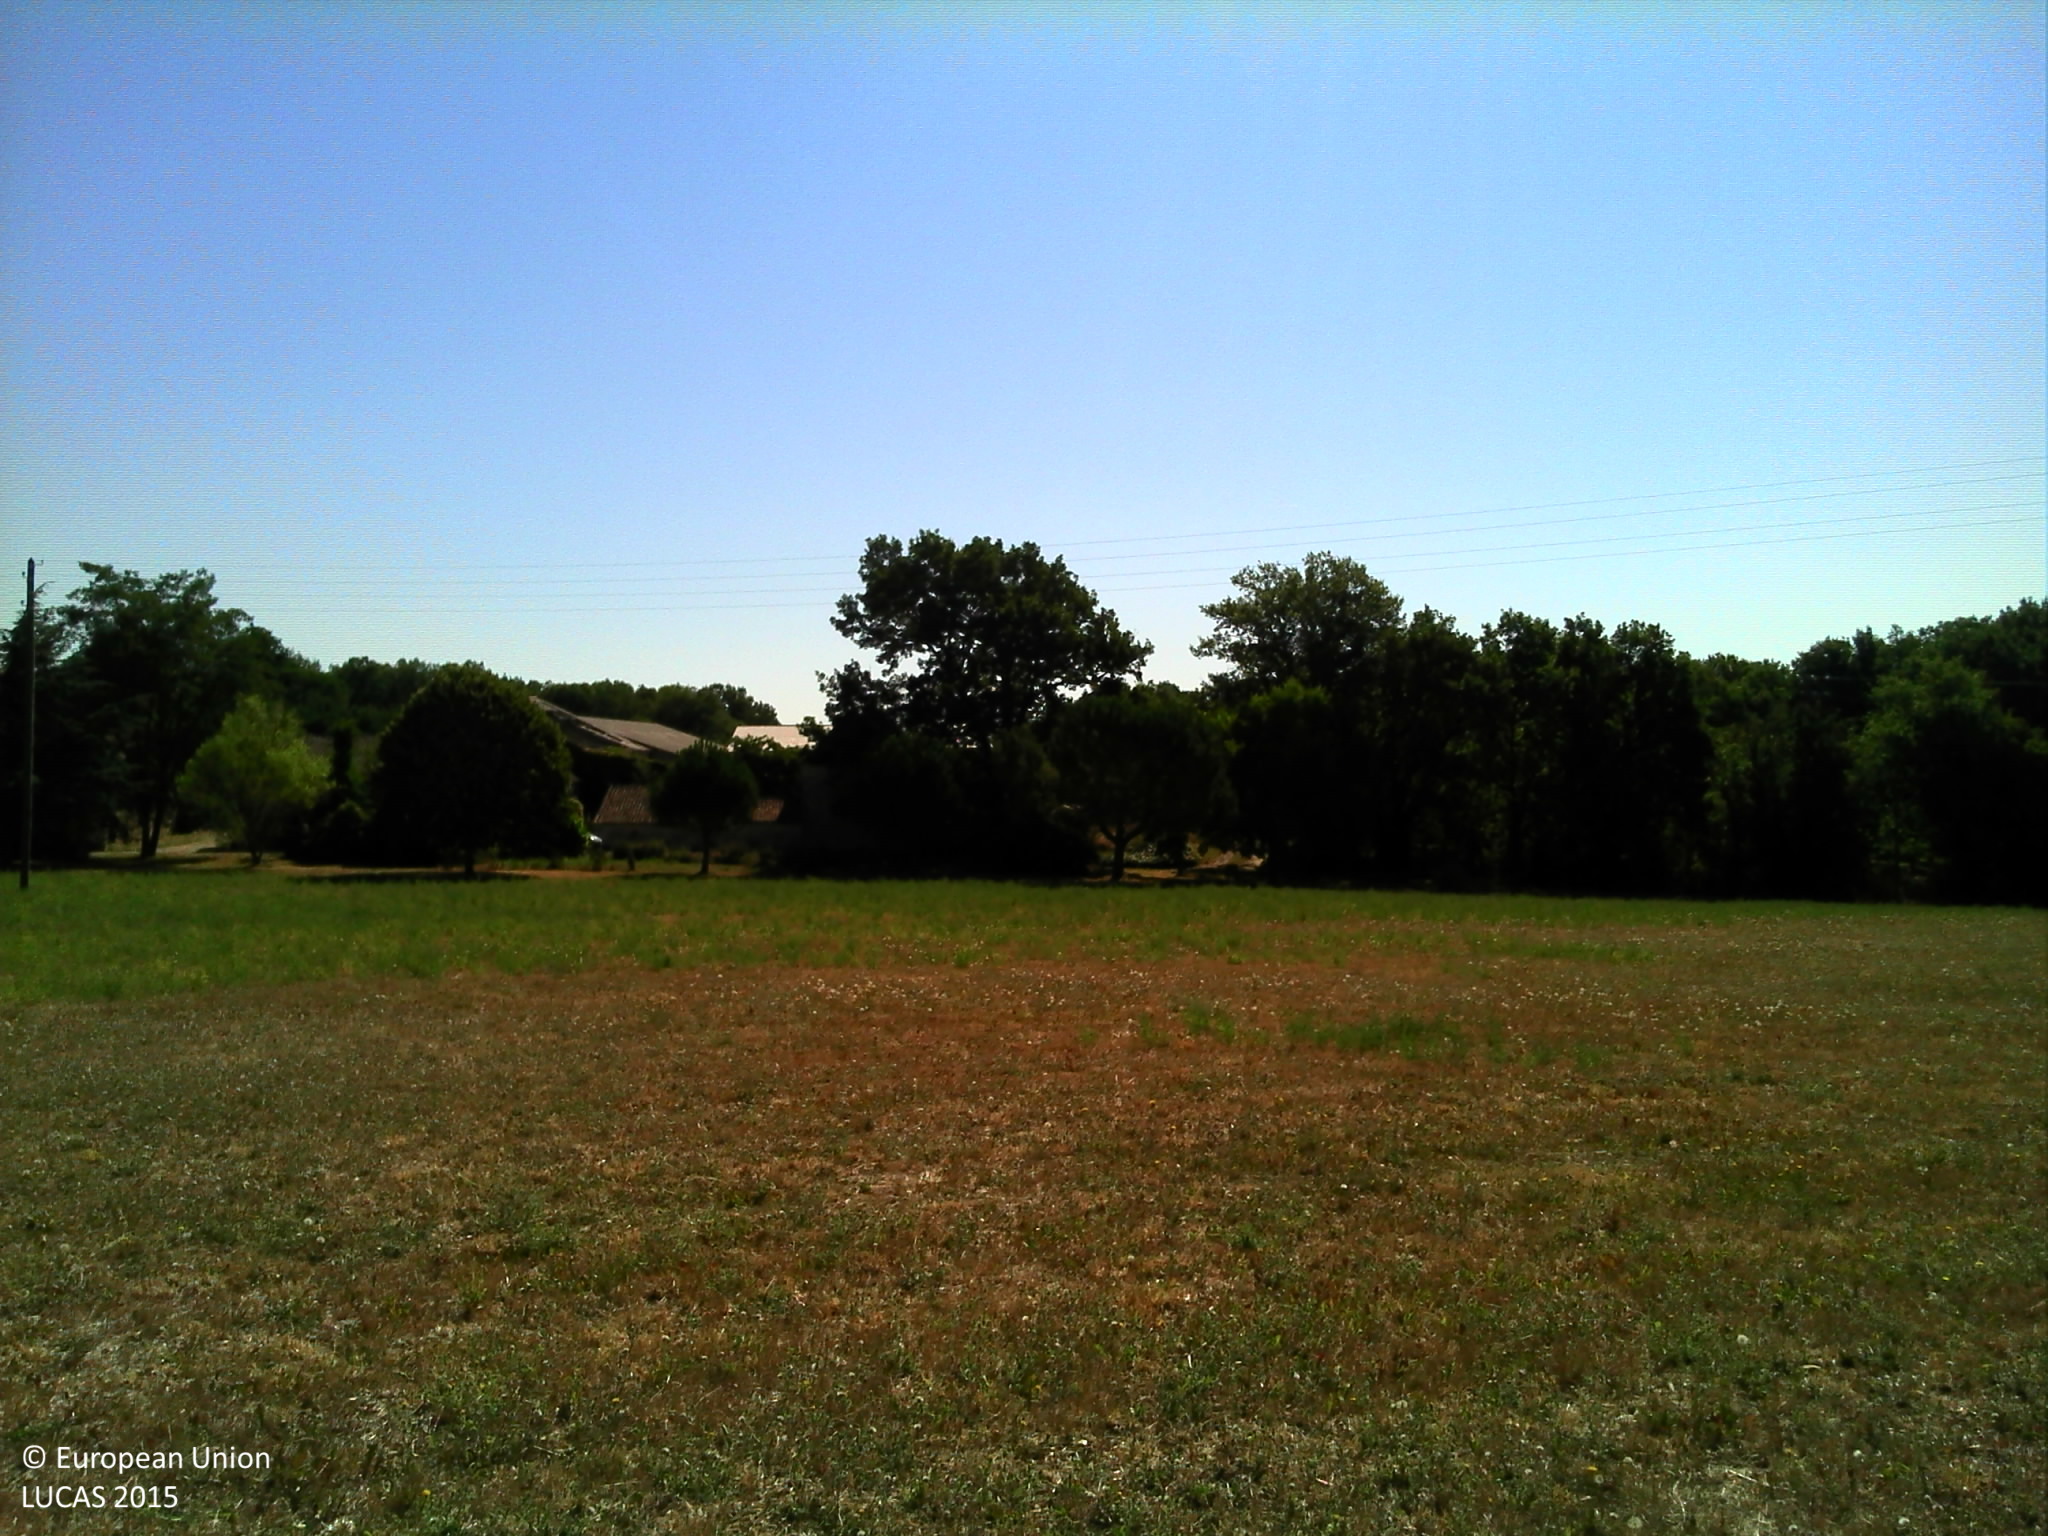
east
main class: Cropland
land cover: Temporary grasslands
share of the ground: > 75 %
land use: Agriculture (excluding fallow land and kitchen gardens)
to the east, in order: Temporary grasslands; Electric lines; Temporary grasslands; Broadleaved woodland; Artificial constructions in urban areas; Nuts trees; Broadleaved woodland
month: August
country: FR
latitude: 44.7760
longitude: 0.6023
